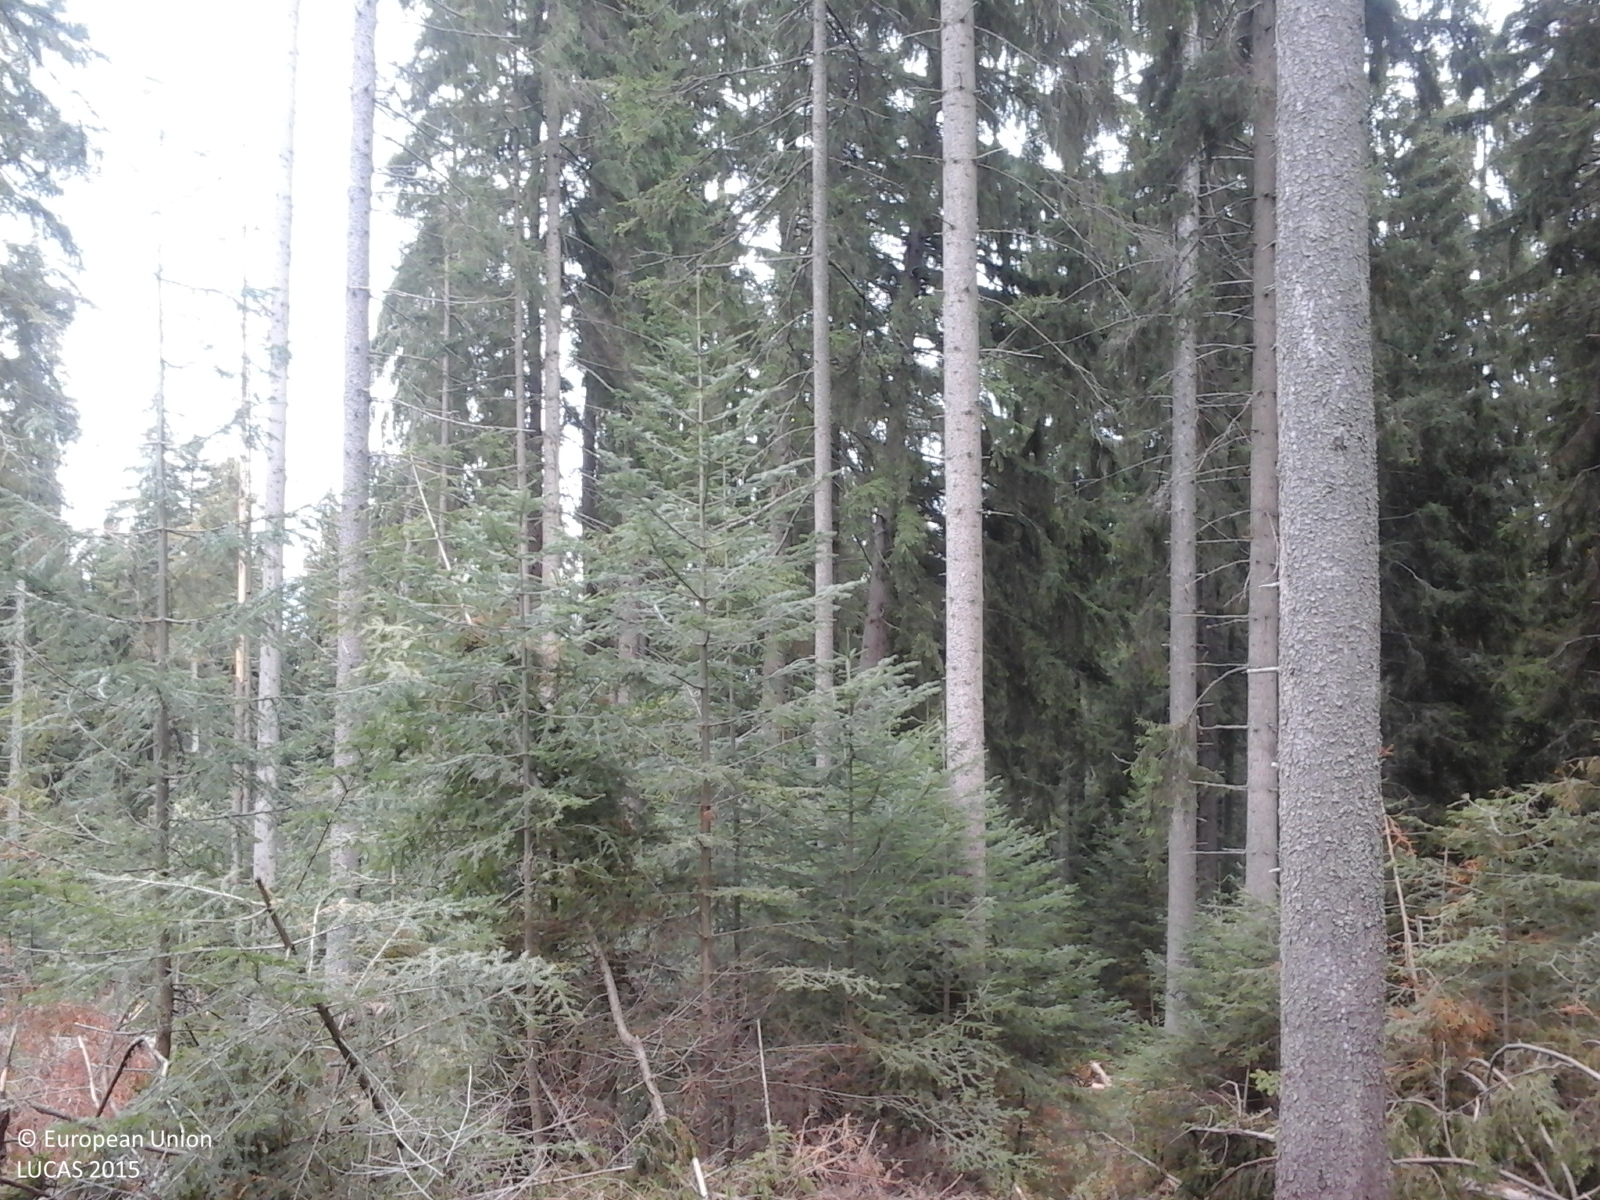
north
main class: Woodland
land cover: Spruce dominated coniferous woodland
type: alpine coniferous forest
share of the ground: > 75 %
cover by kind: coniferous forest trees 100 %
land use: Forestry
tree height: > 5 m
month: October
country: RO
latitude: 46.6190
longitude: 25.5329
